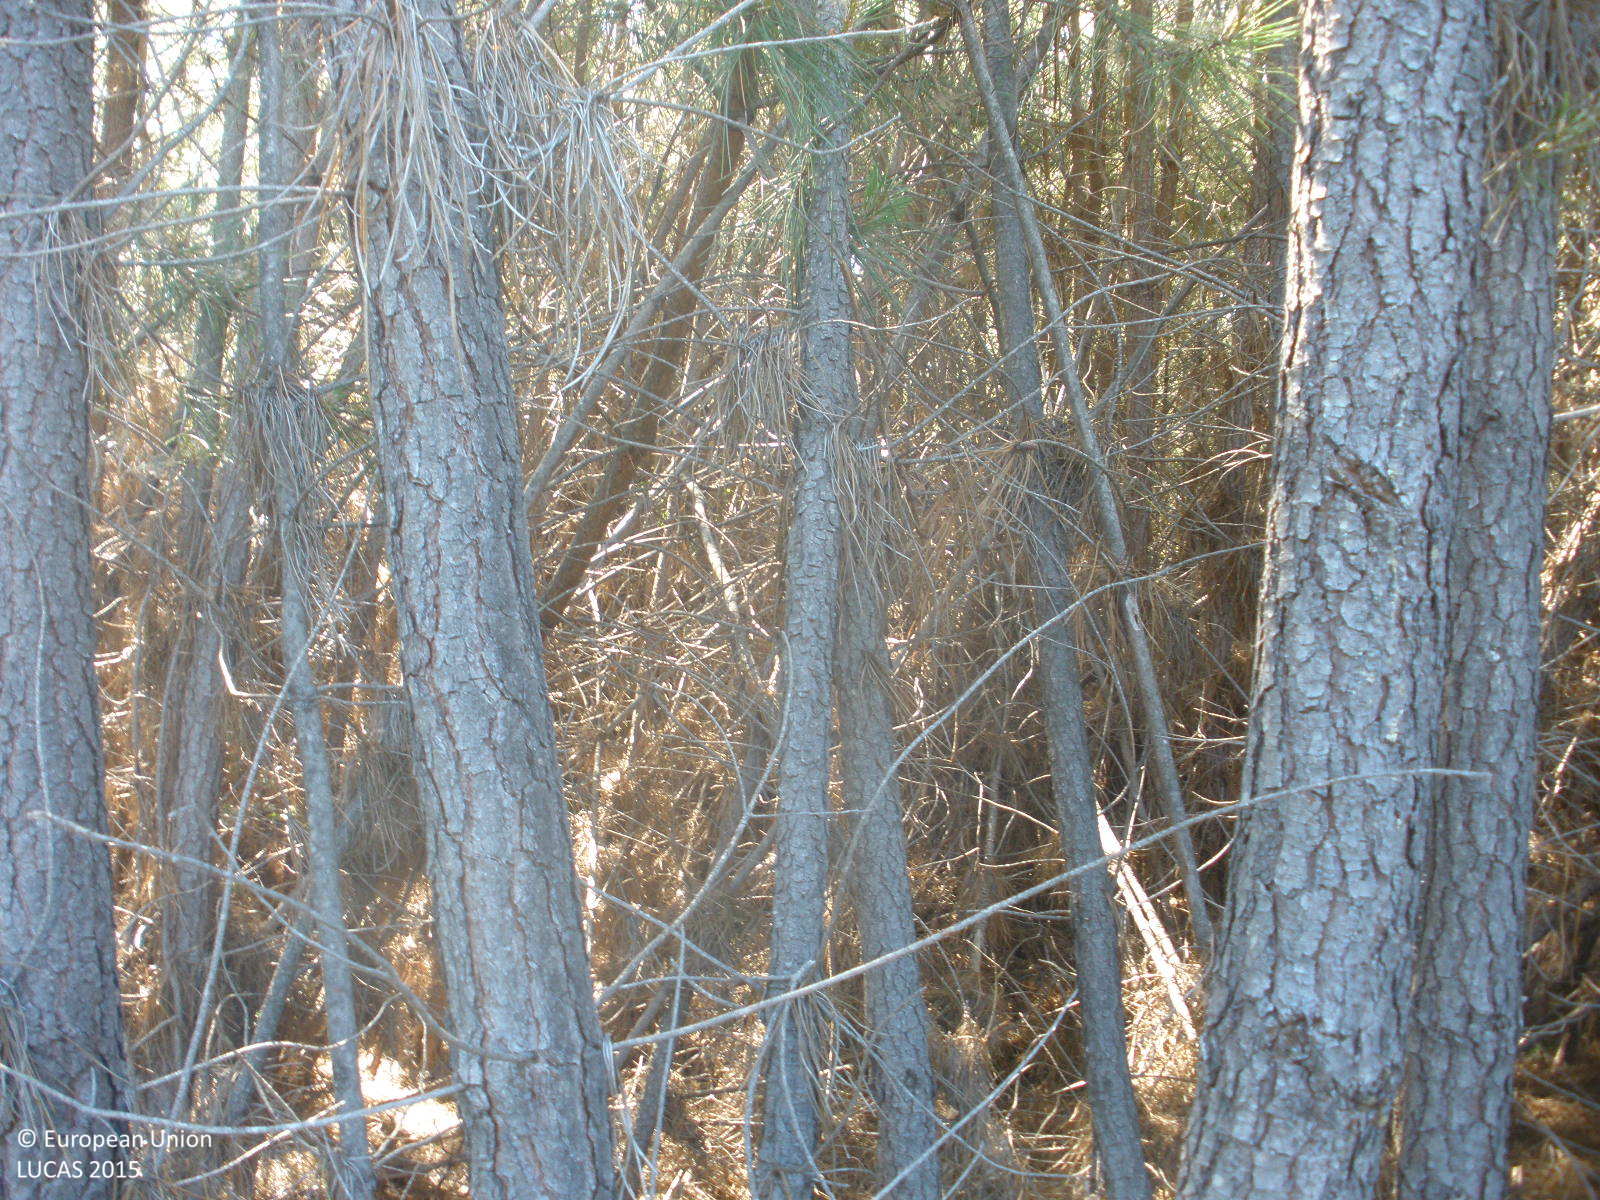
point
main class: Woodland
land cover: Pine dominated coniferous woodland
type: coniferous forest of the mediterranean region
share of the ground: > 75 %
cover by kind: coniferous forest trees 90 %, shrubs 10 %
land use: Forestry
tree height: > 5 m
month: May
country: ES
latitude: 40.2106
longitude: -6.5688
